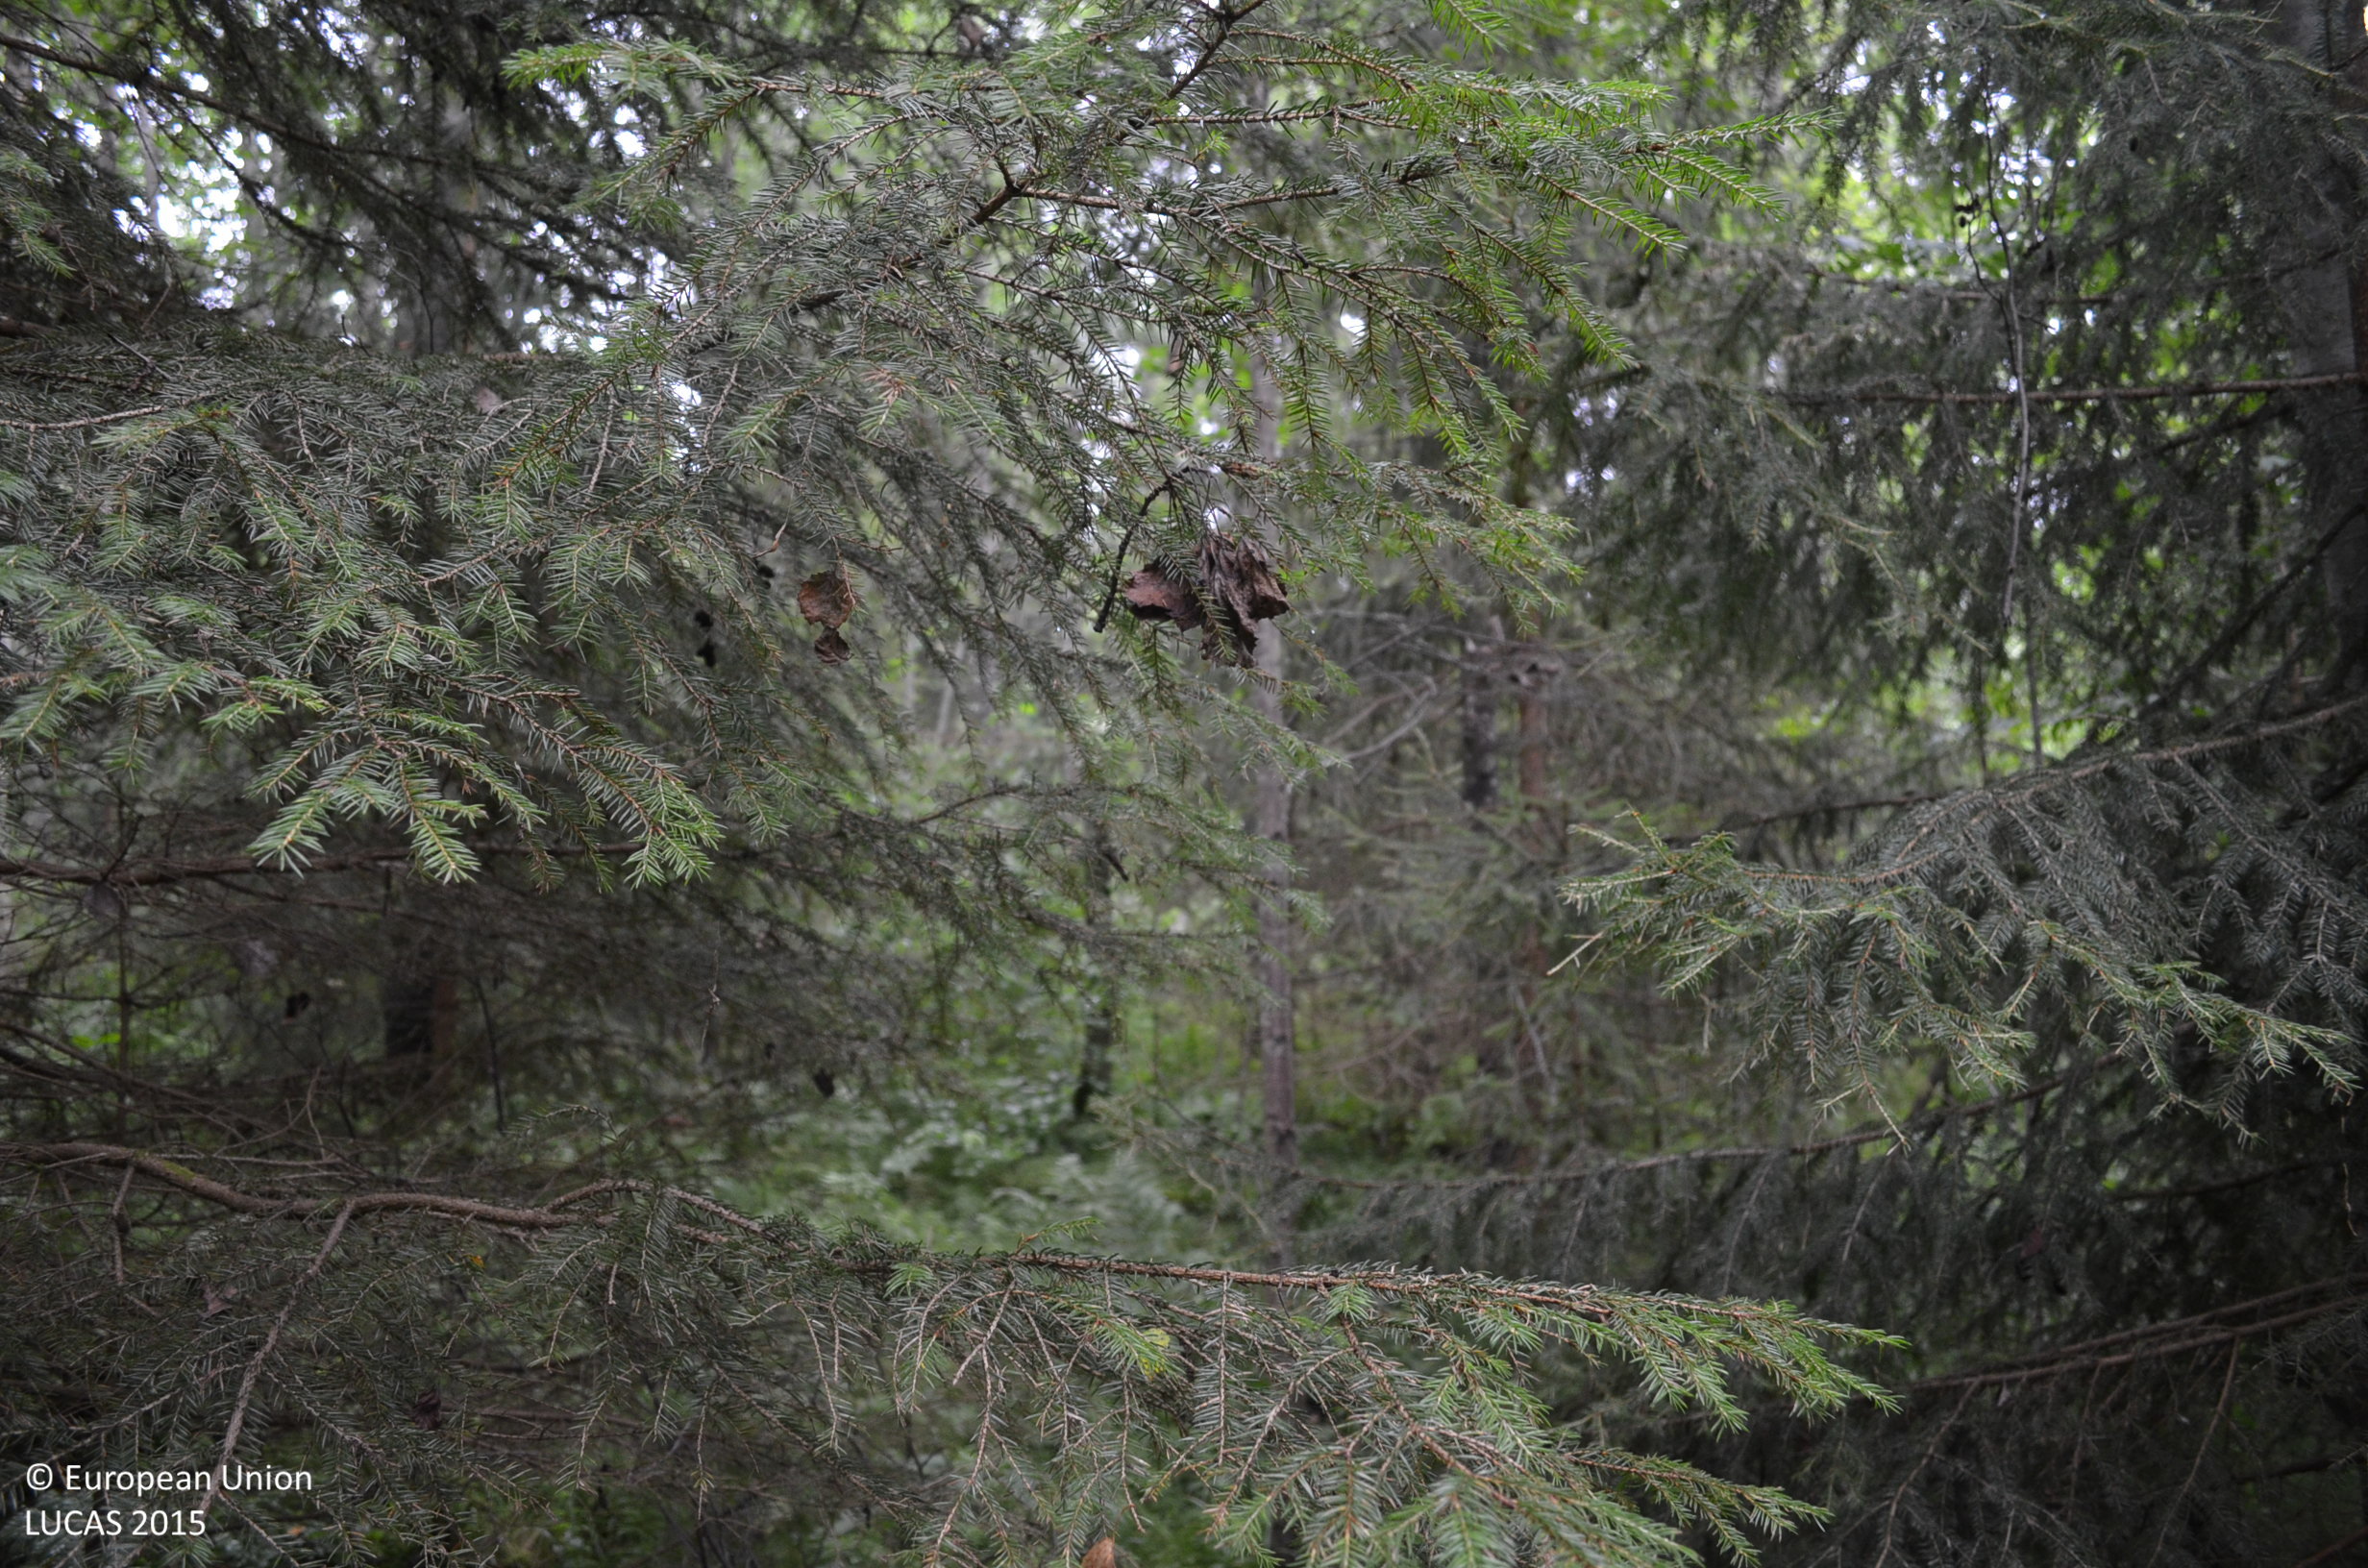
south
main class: Woodland
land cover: Broadleaved woodland
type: boreal forest
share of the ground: > 75 %
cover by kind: broadleaved forest trees 80 %, coniferous forest trees 10 %, herbaceous plants 10 %
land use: Forestry
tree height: > 5 m
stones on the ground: < 10 %
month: August
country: FI
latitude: 61.9131
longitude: 24.0419
